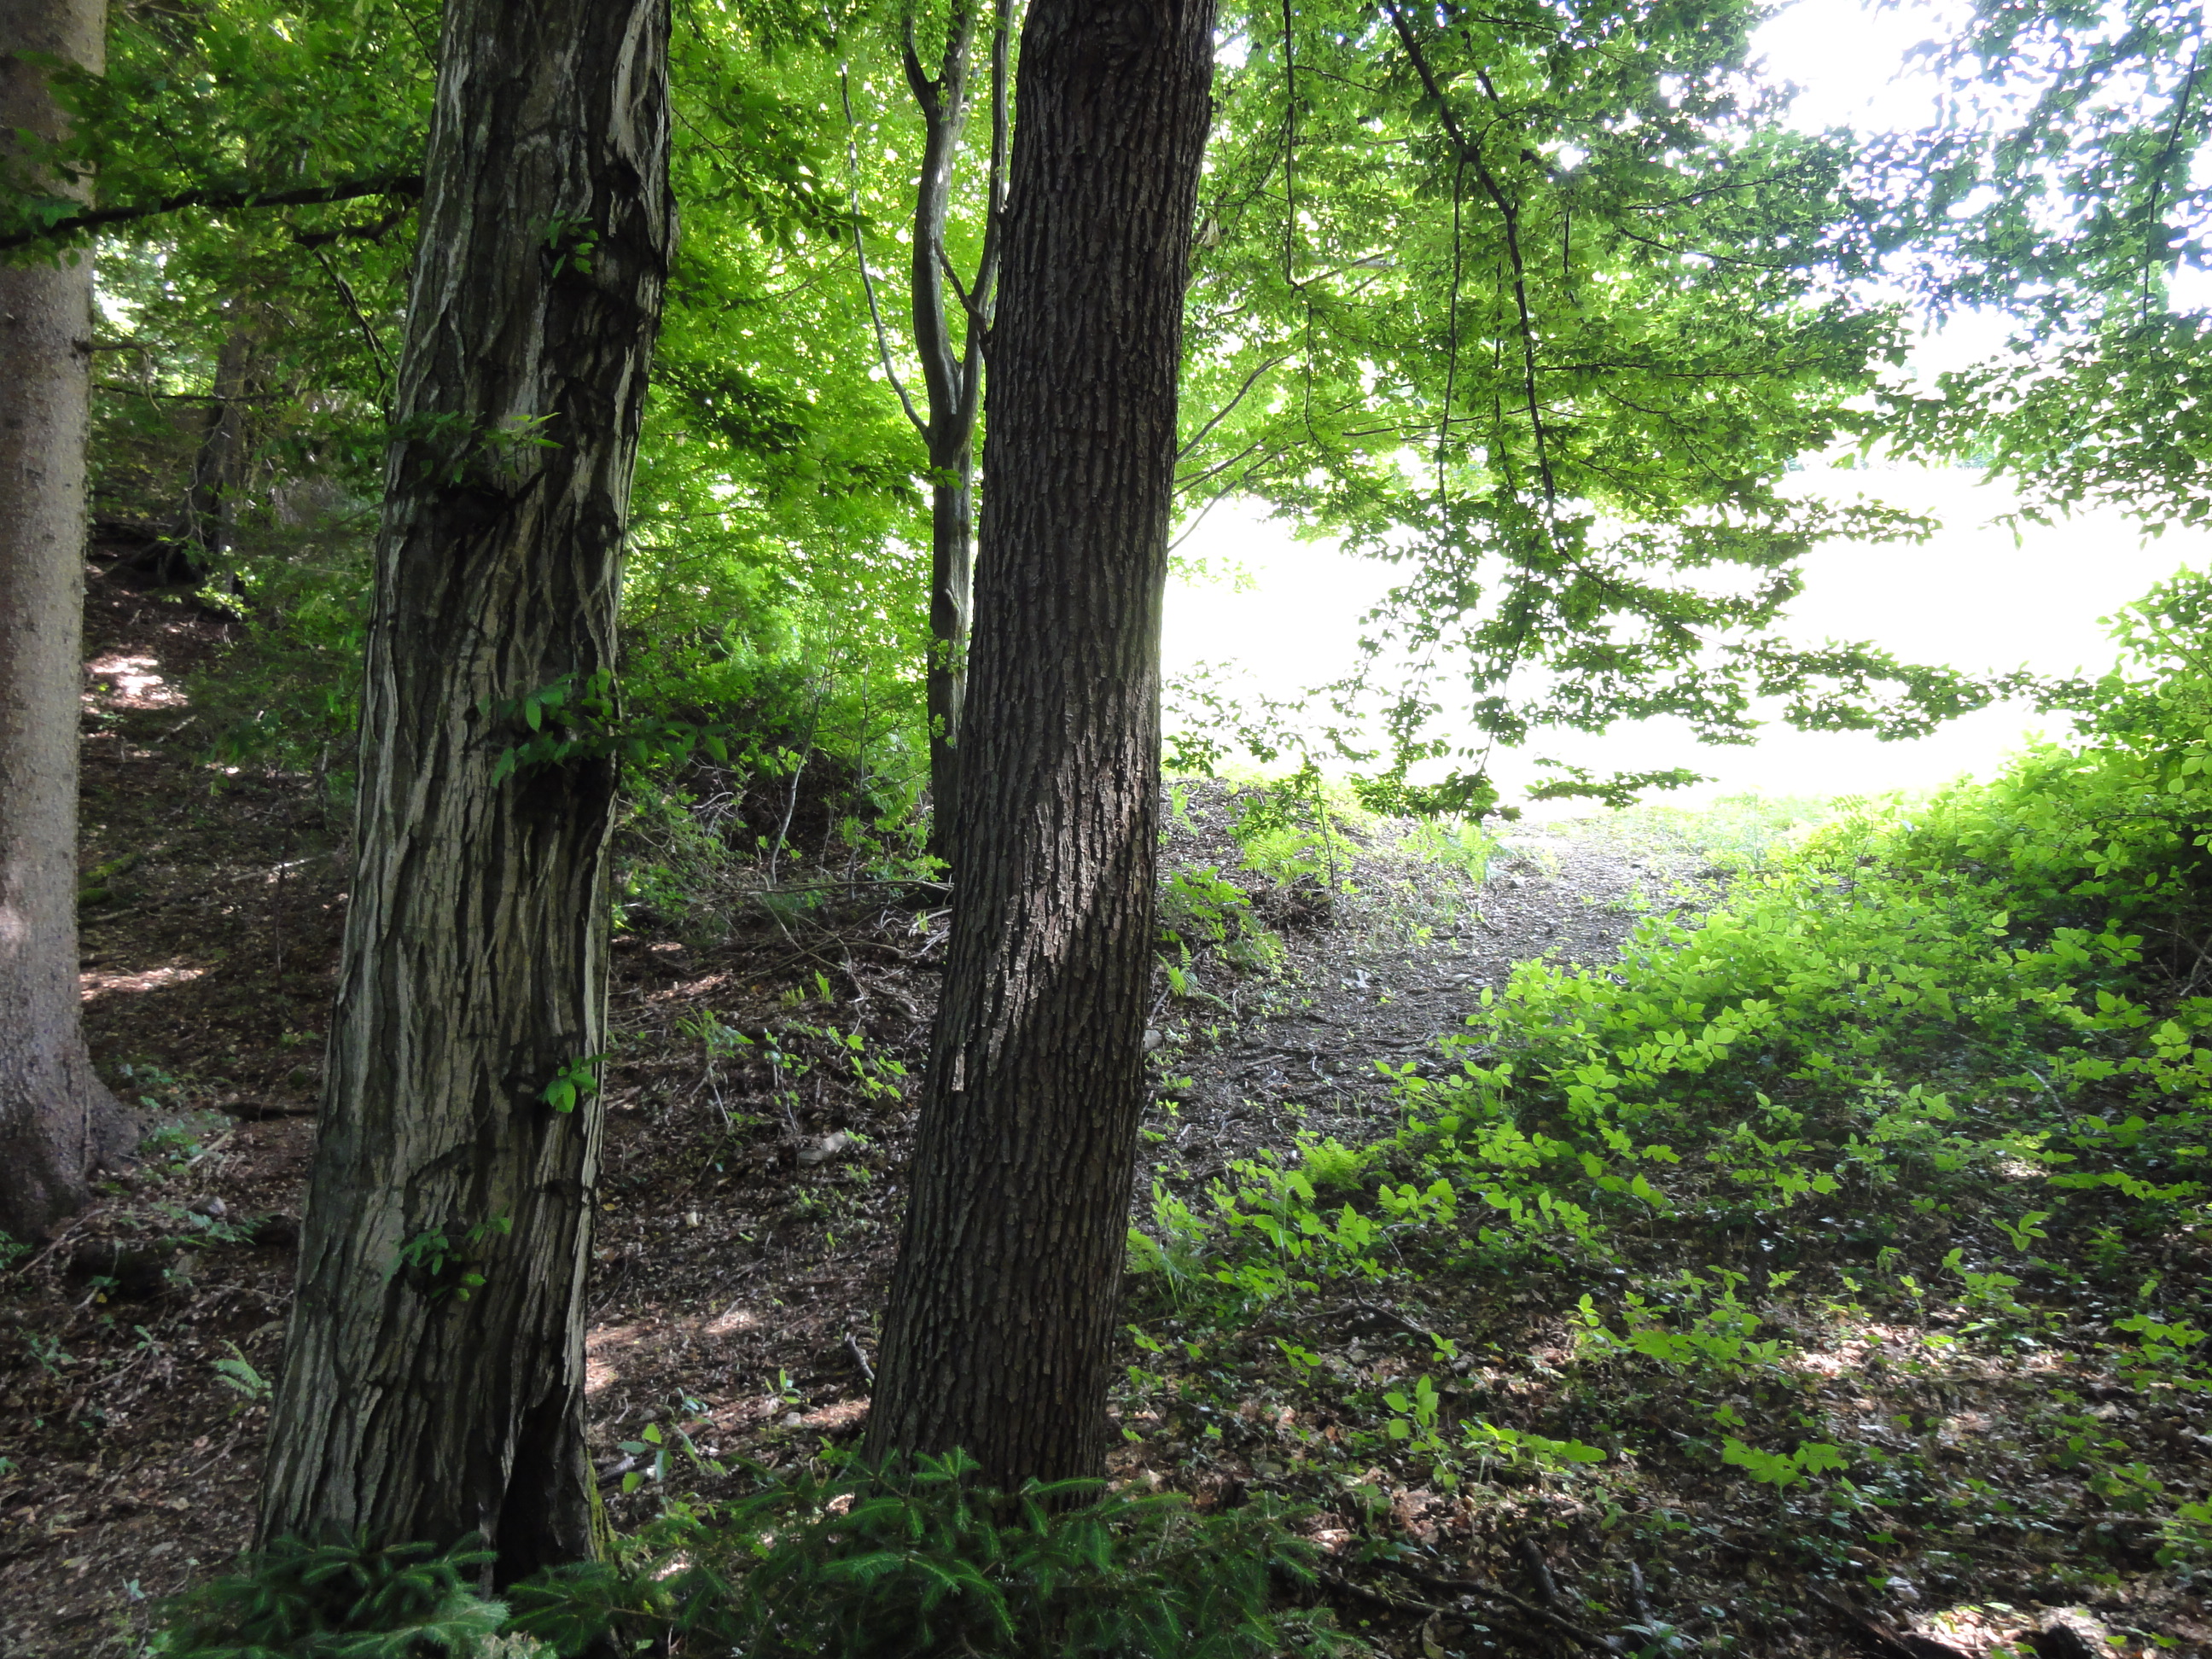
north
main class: Woodland
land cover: Spruce dominated mixed woodland
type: mountainous beech forest
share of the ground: > 75 %
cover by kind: broadleaved forest trees 65 %, coniferous forest trees 35 %
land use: Forestry
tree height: > 5 m
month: June
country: SI
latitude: 46.1772
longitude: 15.0622
